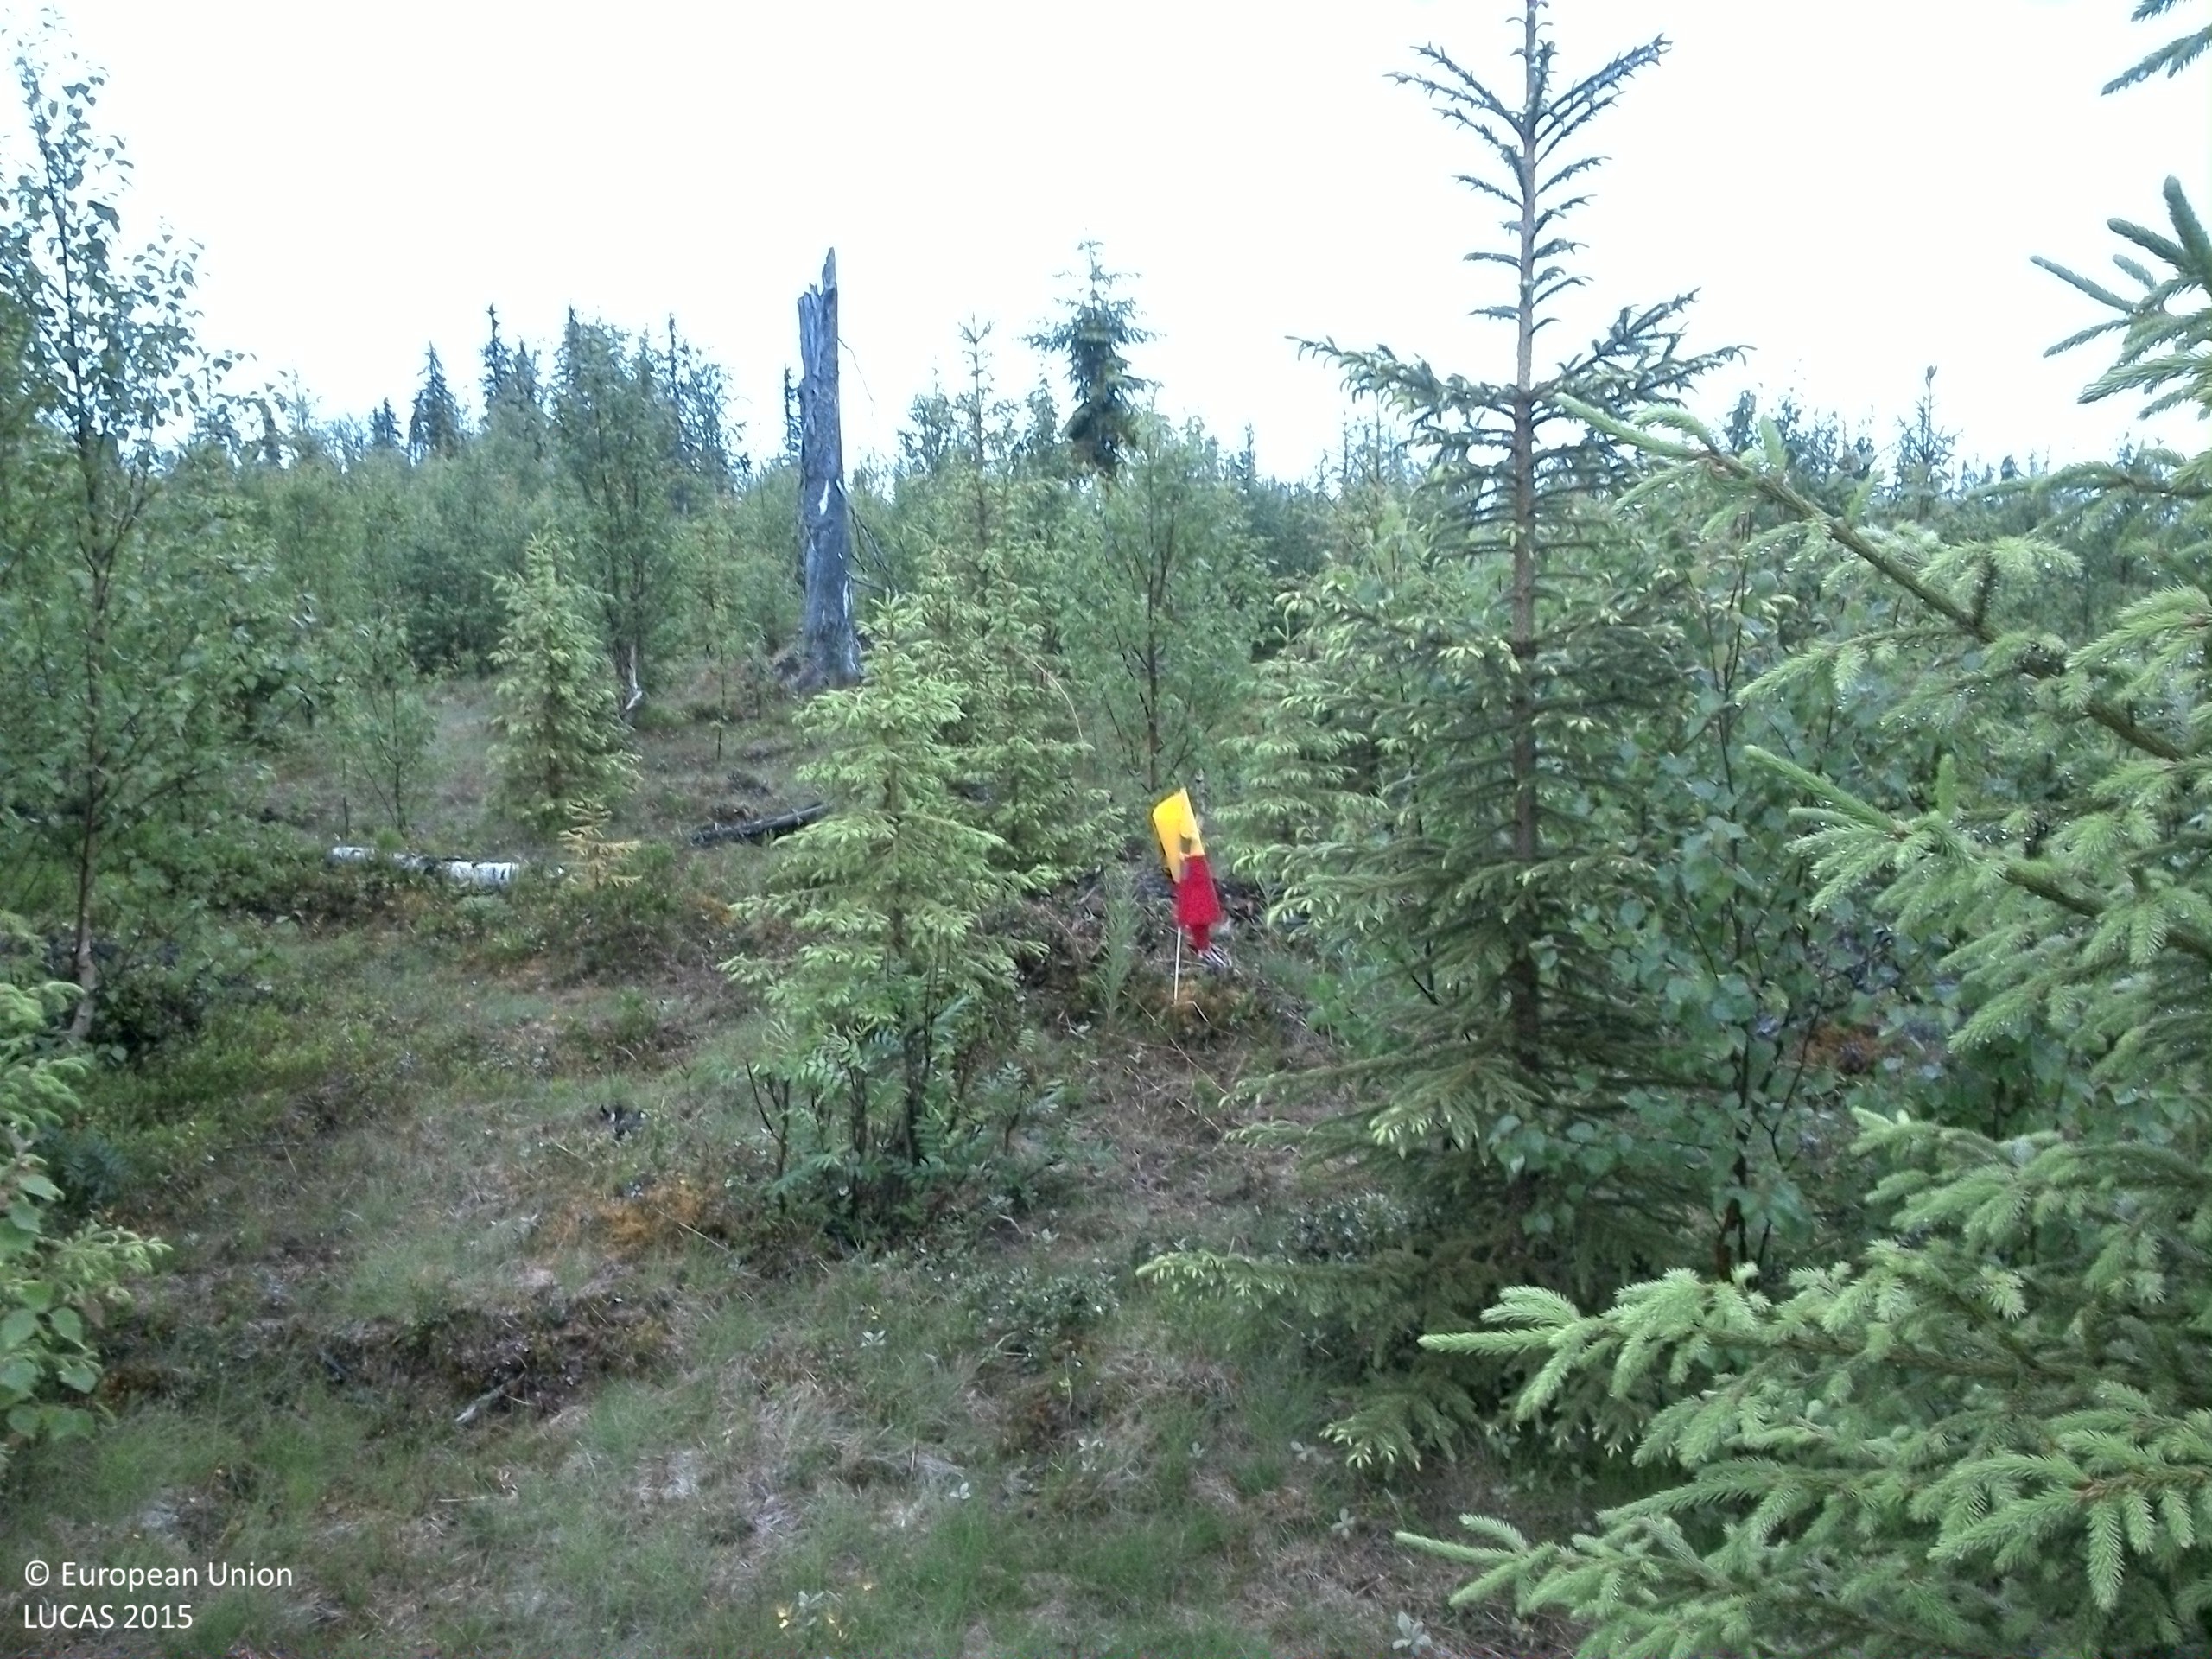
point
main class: Woodland
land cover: Spruce dominated mixed woodland
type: boreal forest
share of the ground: 50 - 75 %
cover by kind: coniferous forest trees 40 %, broadleaved forest trees 25 %, shrubs 15 %, herbaceous plants 10 %, lichens and mosses 10 %
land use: Forestry
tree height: < 5 m
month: July
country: SE
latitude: 64.4148
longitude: 16.3815
